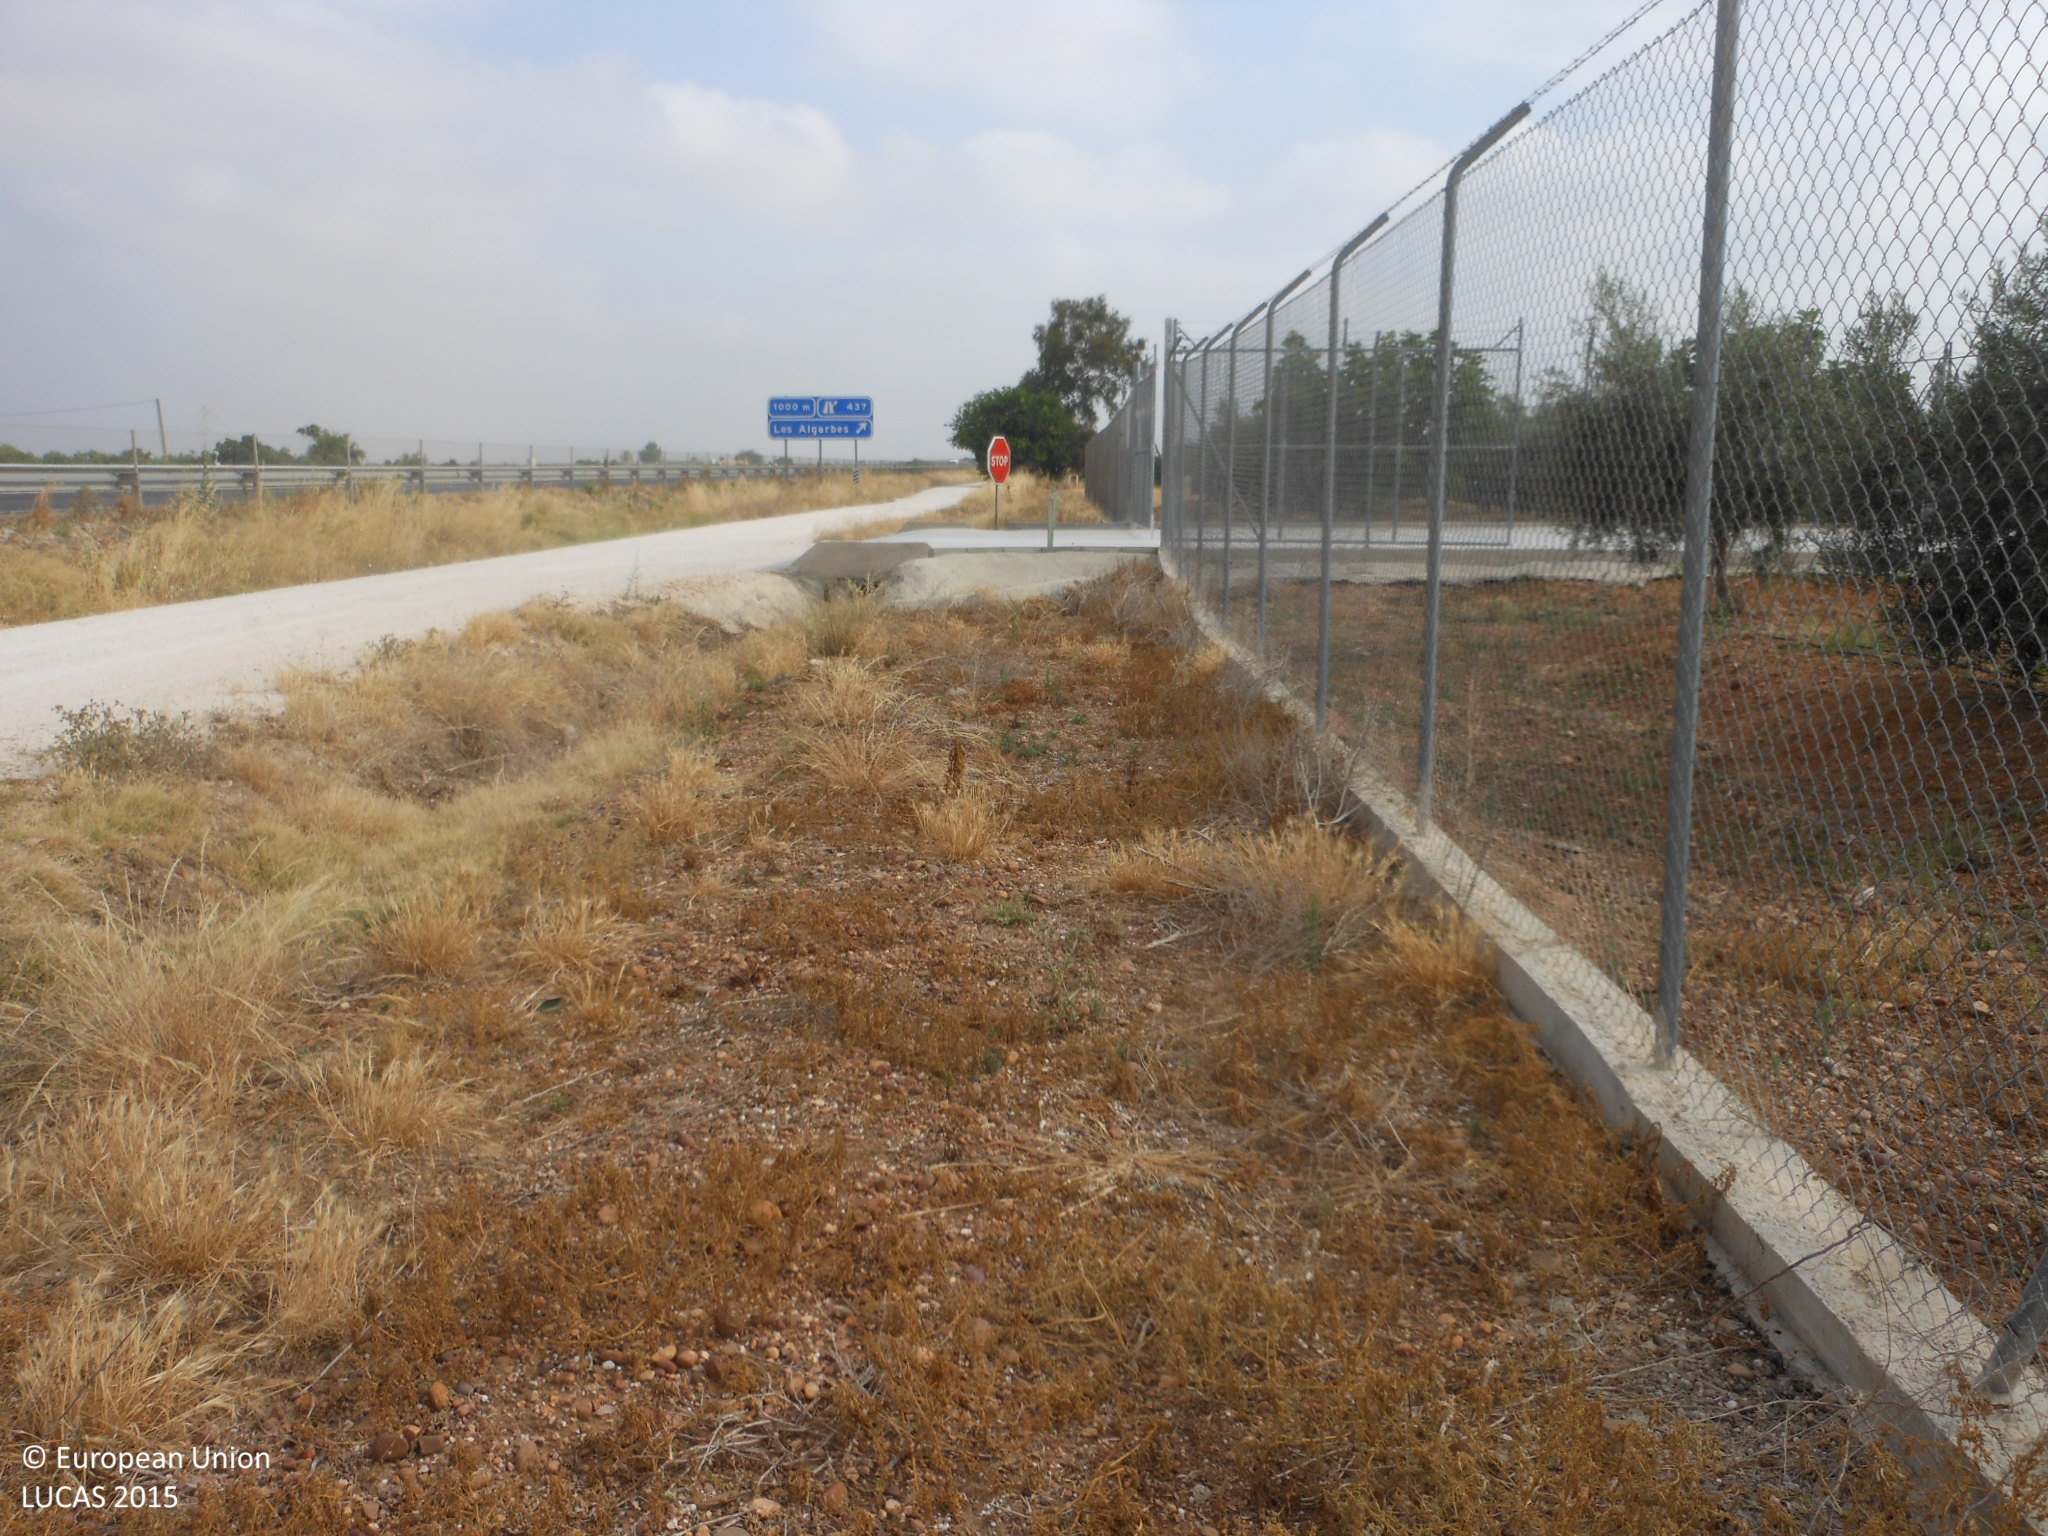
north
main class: Cropland
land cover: Olive groves
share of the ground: 50 - 75 %
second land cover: Other bare soil
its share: > 75 %
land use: Agriculture (excluding fallow land and kitchen gardens)
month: June
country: ES
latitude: 37.6246
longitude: -4.9572
